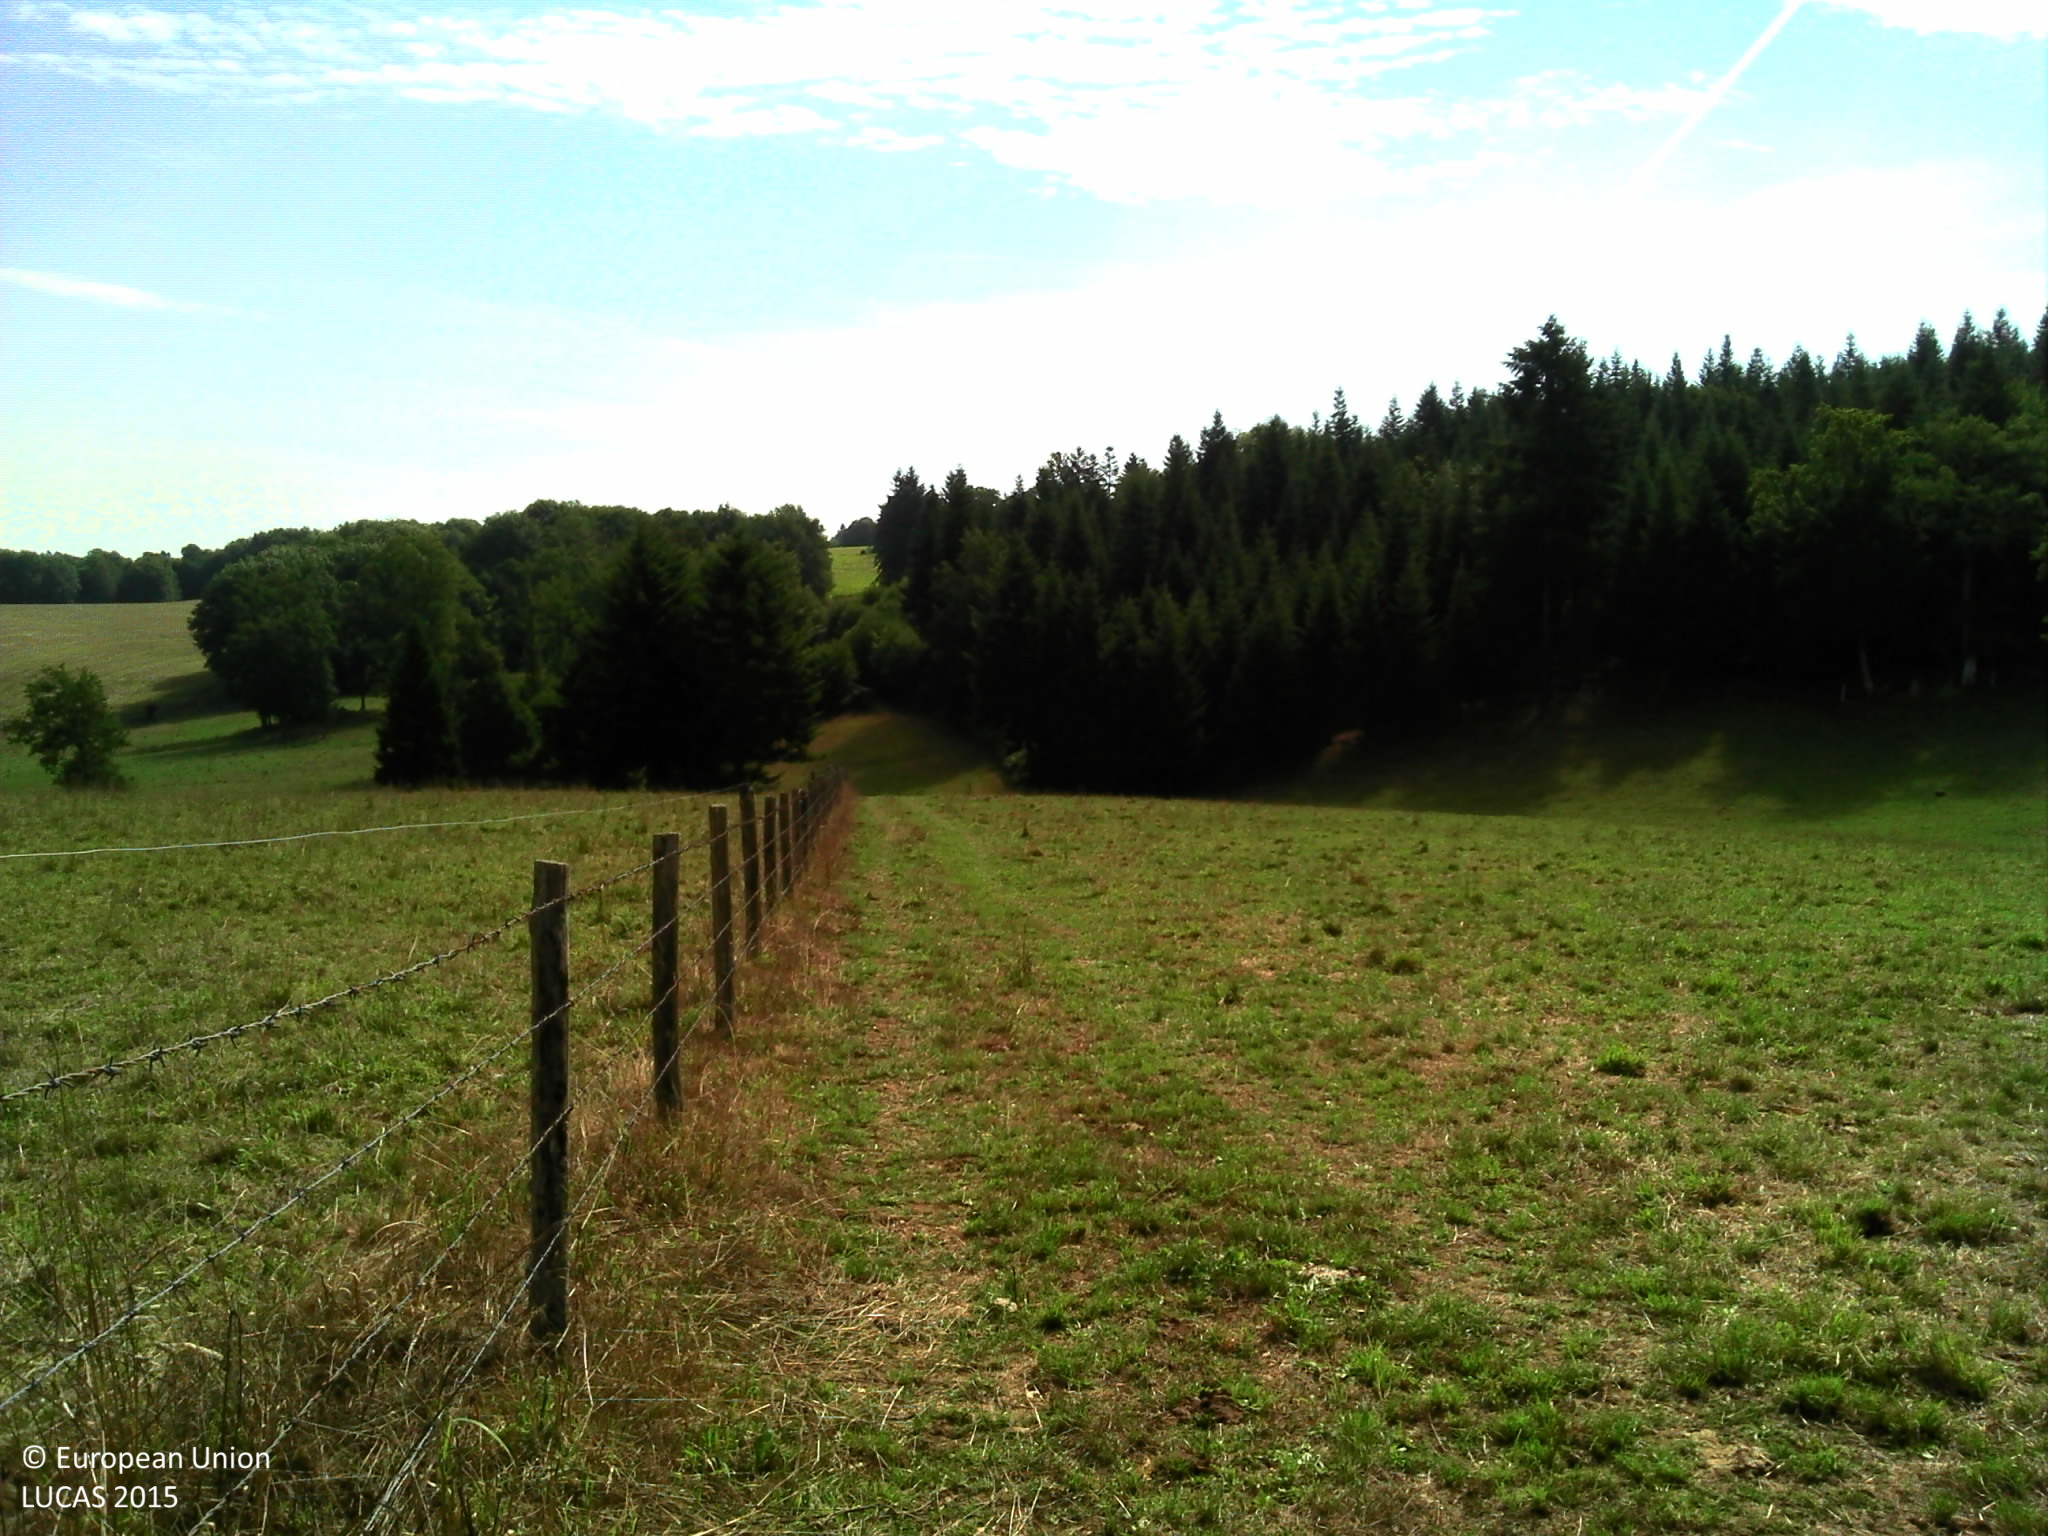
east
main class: Grassland
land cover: Grassland without tree/shrub cover
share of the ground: > 75 %
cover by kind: herbaceous plants 95 %
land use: Agriculture (excluding fallow land and kitchen gardens)
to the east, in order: Grassland without tree/shrub cover; Single bushes/trees; Fences; Grassland without tree/shrub cover
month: August
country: FR
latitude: 45.6145
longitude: 1.2846
